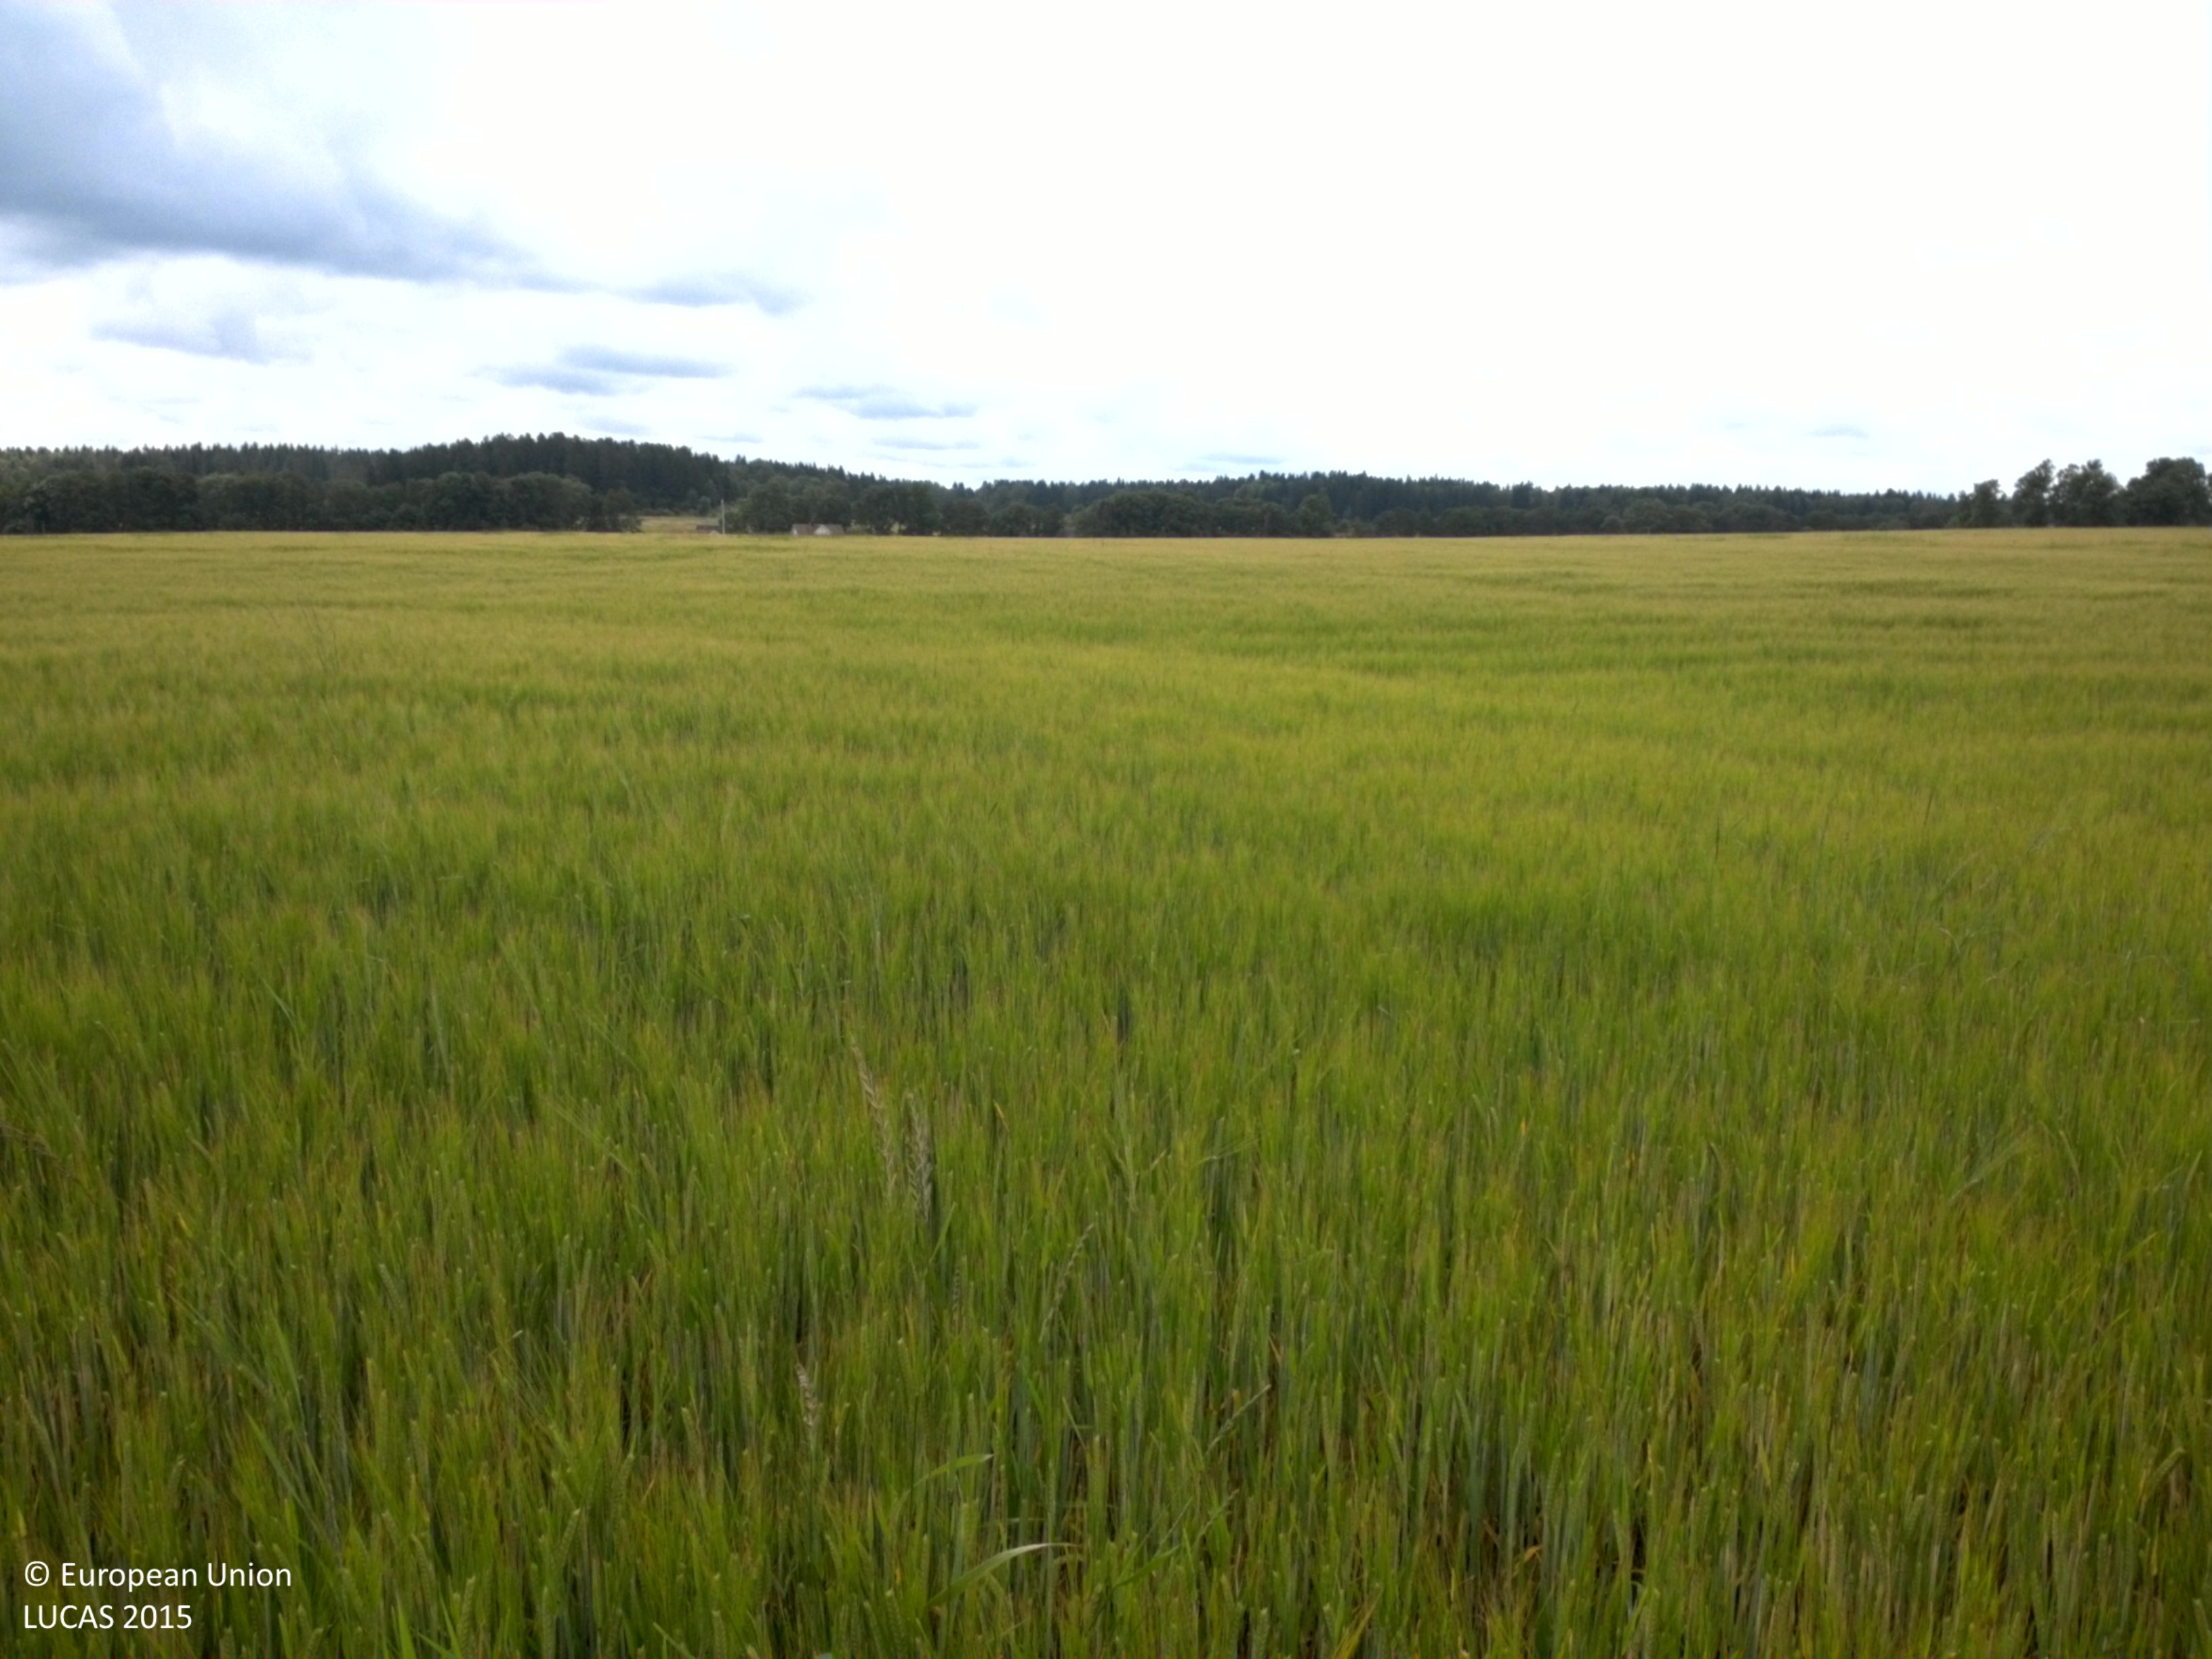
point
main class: Cropland
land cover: Barley
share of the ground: > 75 %
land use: Agriculture (excluding fallow land and kitchen gardens)
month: July
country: SE
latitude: 59.8598
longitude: 18.6588
